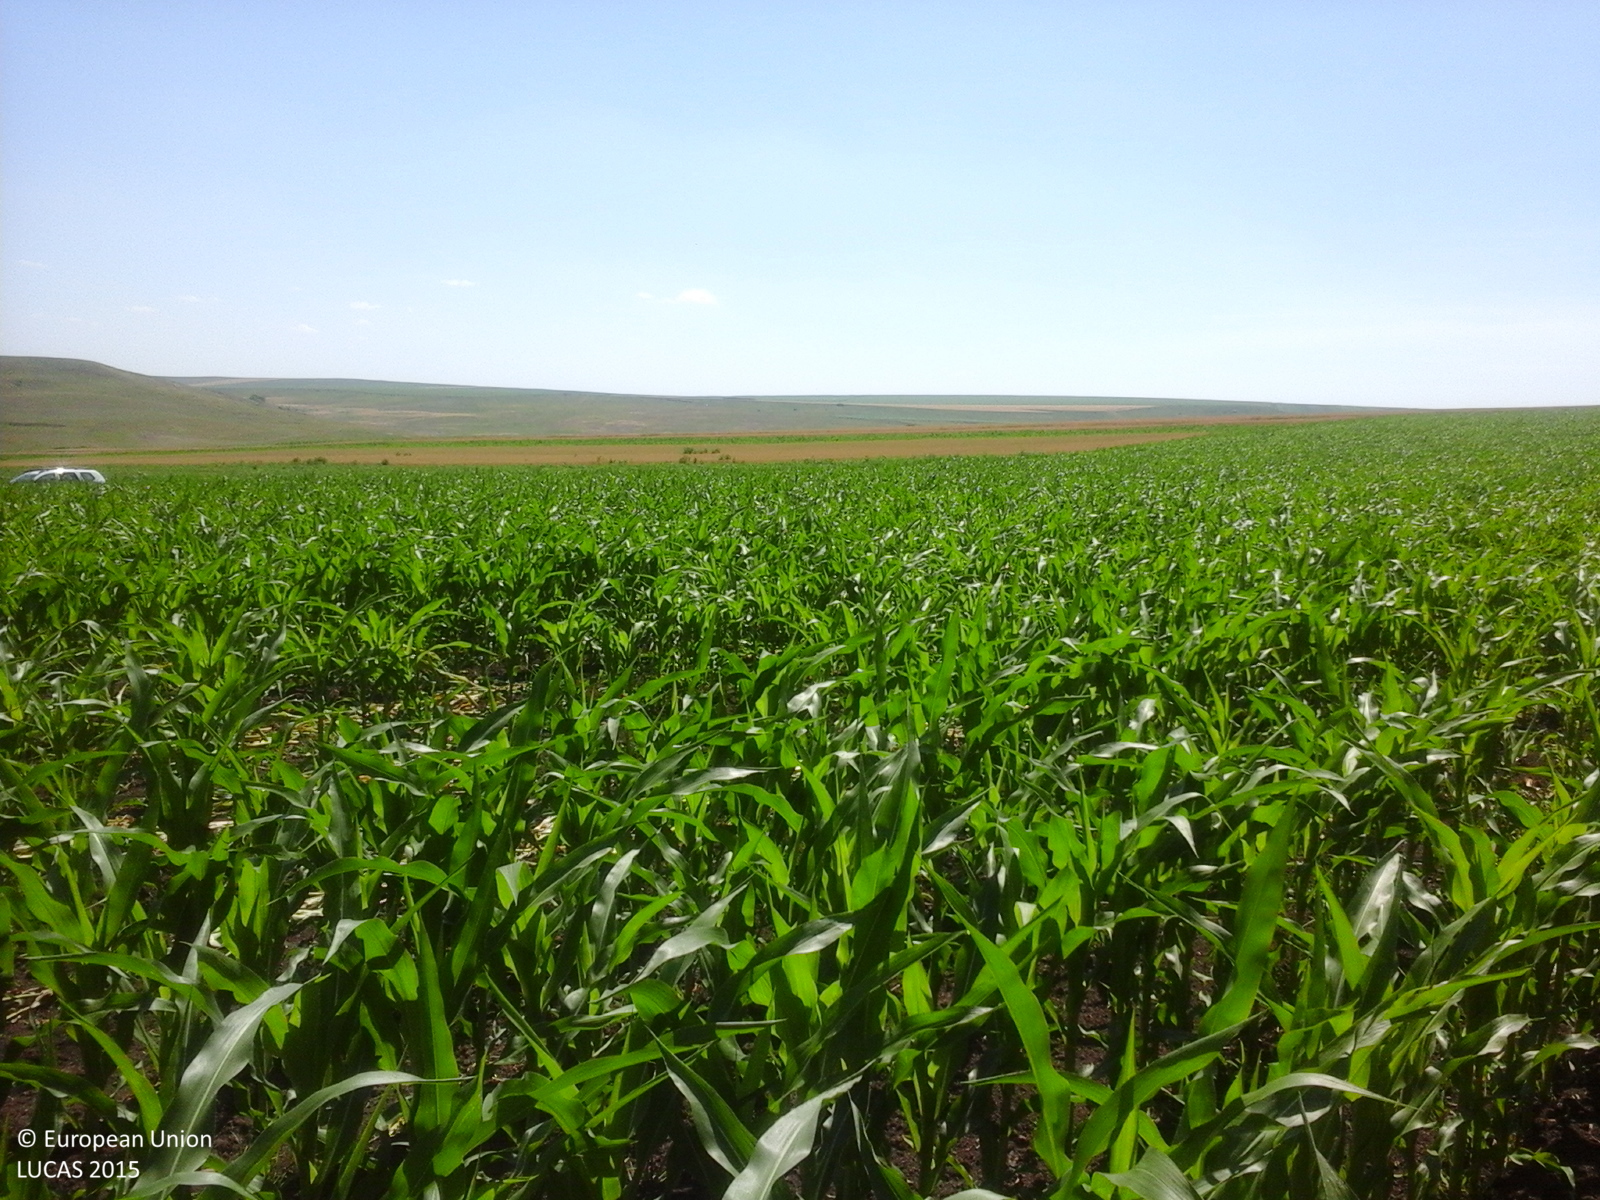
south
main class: Cropland
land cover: Maize
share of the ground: > 75 %
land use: Agriculture (excluding fallow land and kitchen gardens)
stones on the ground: < 10 %
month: June
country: RO
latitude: 47.7244
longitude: 27.1885
